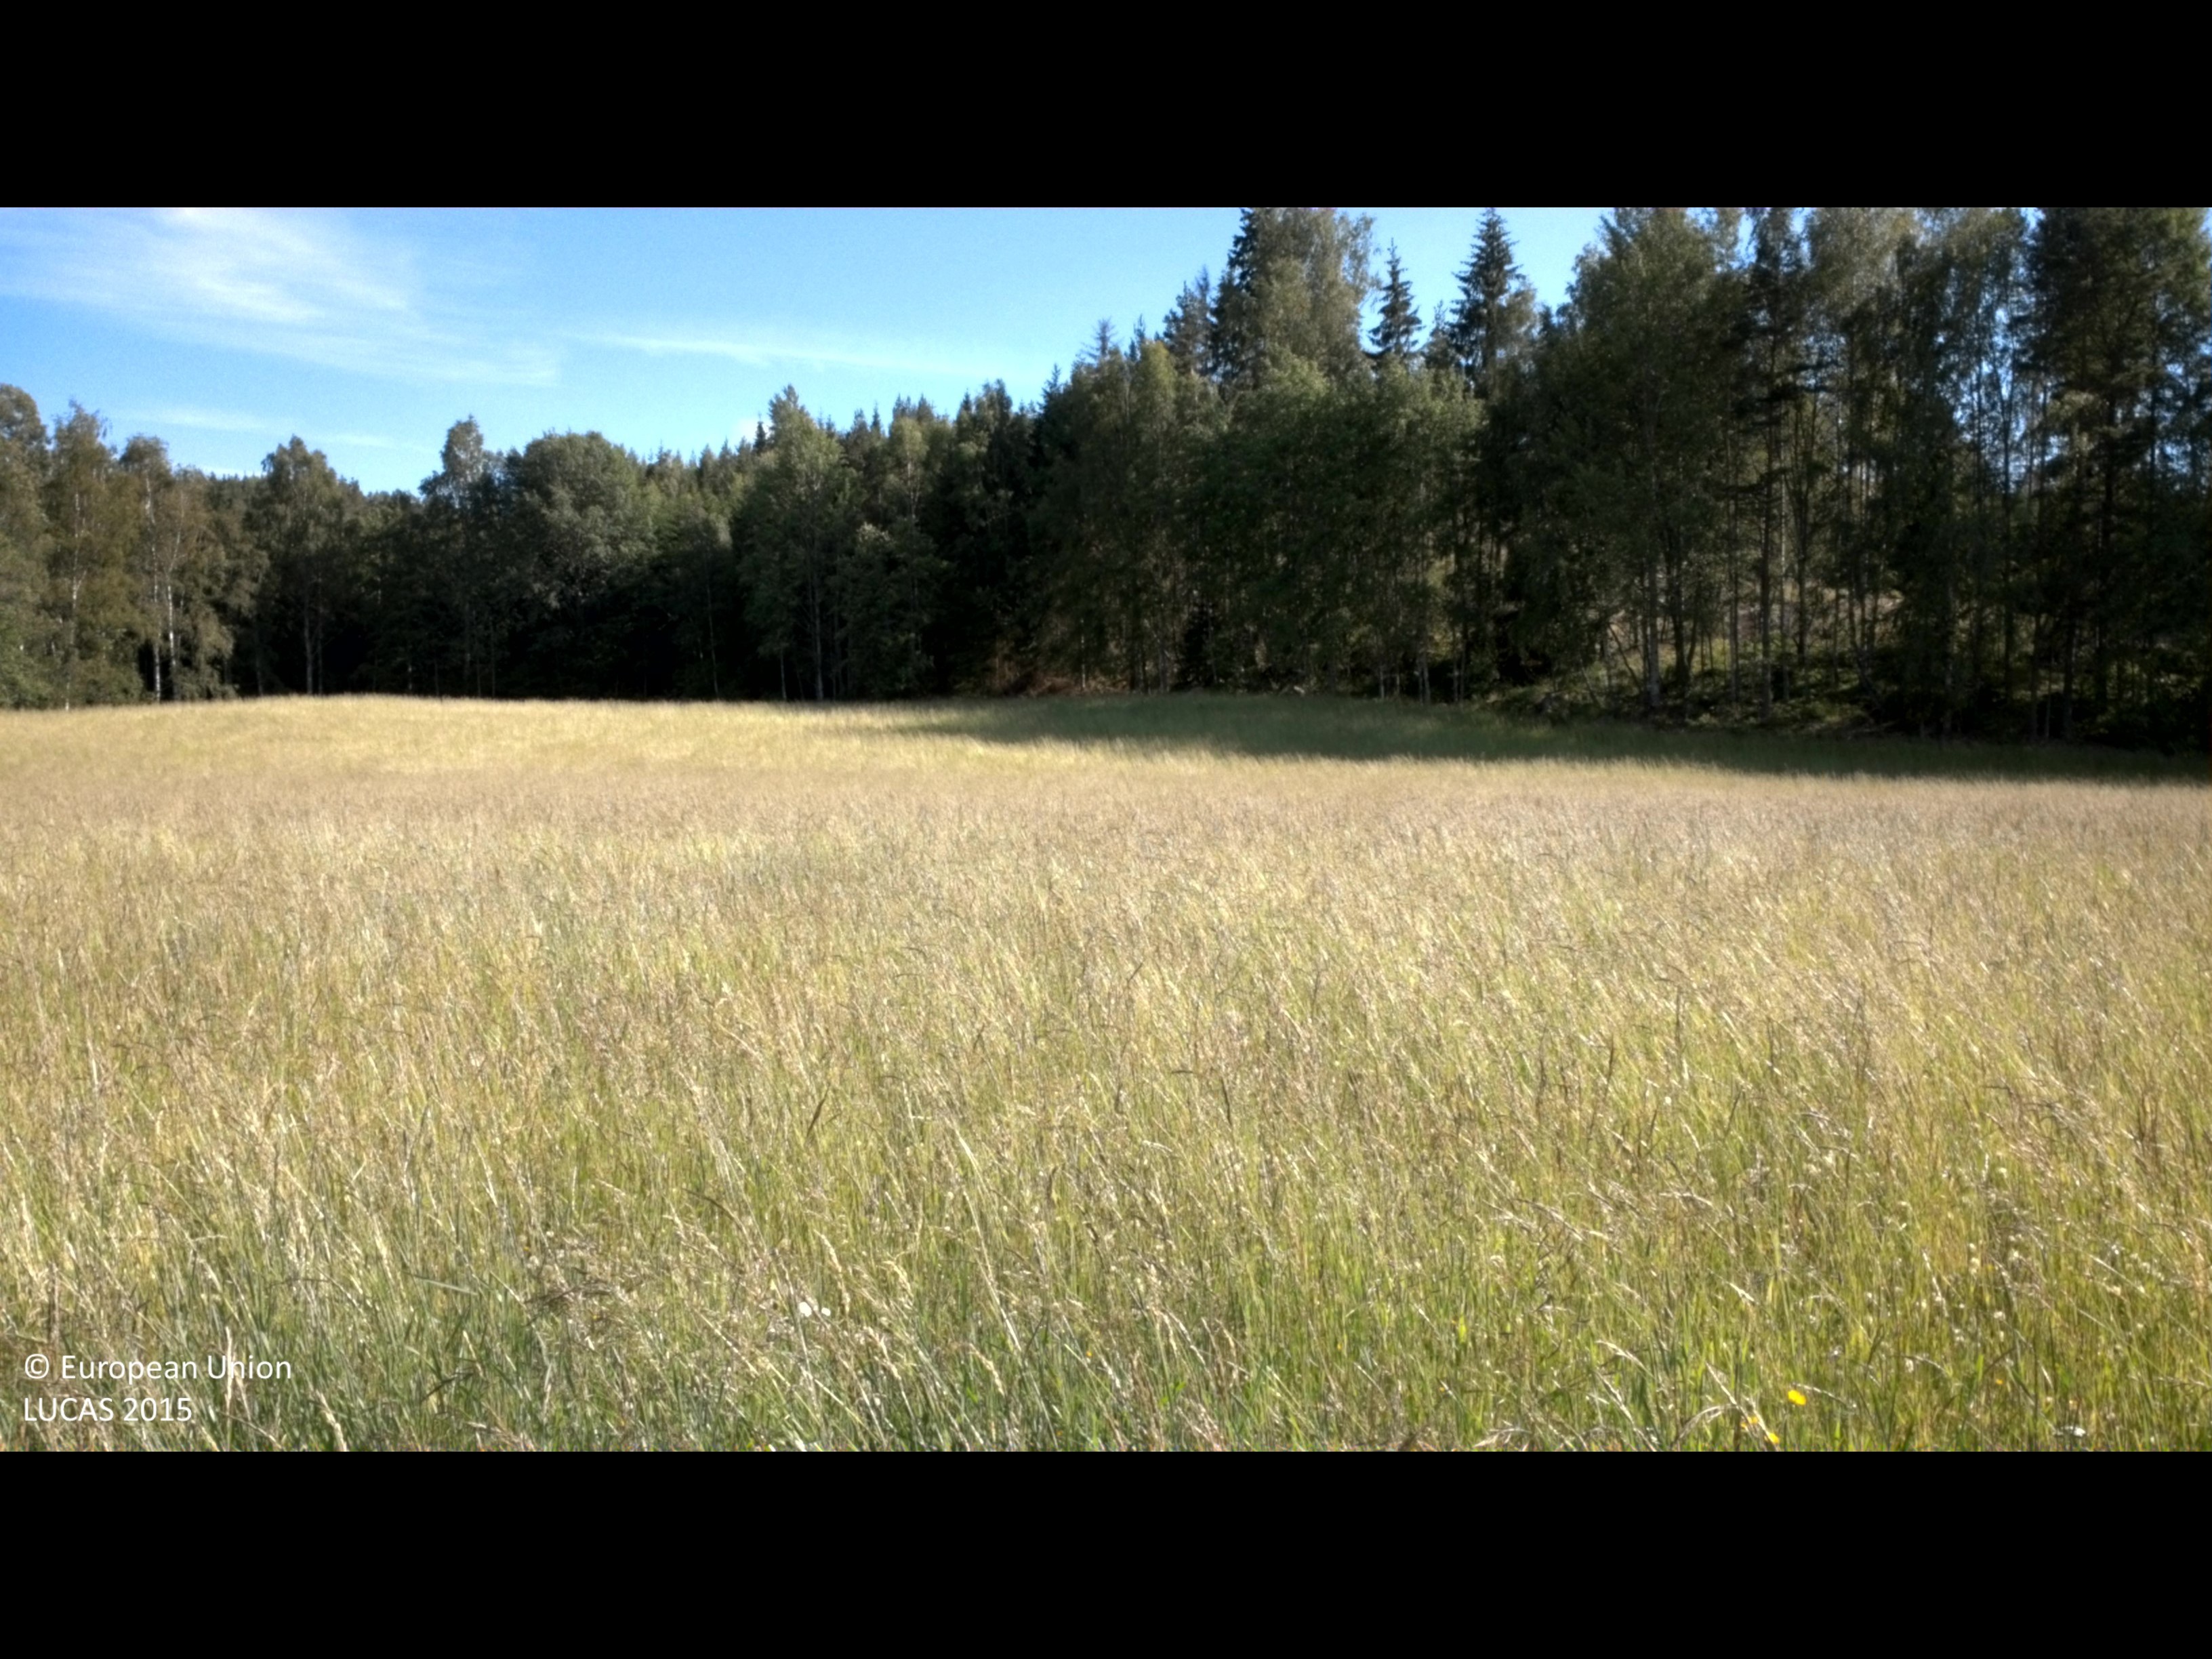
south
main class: Cropland
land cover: Other leguminous and mixtures for fodder
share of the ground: > 75 %
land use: Agriculture (excluding fallow land and kitchen gardens)
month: June
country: SE
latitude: 58.2235
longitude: 16.1423
